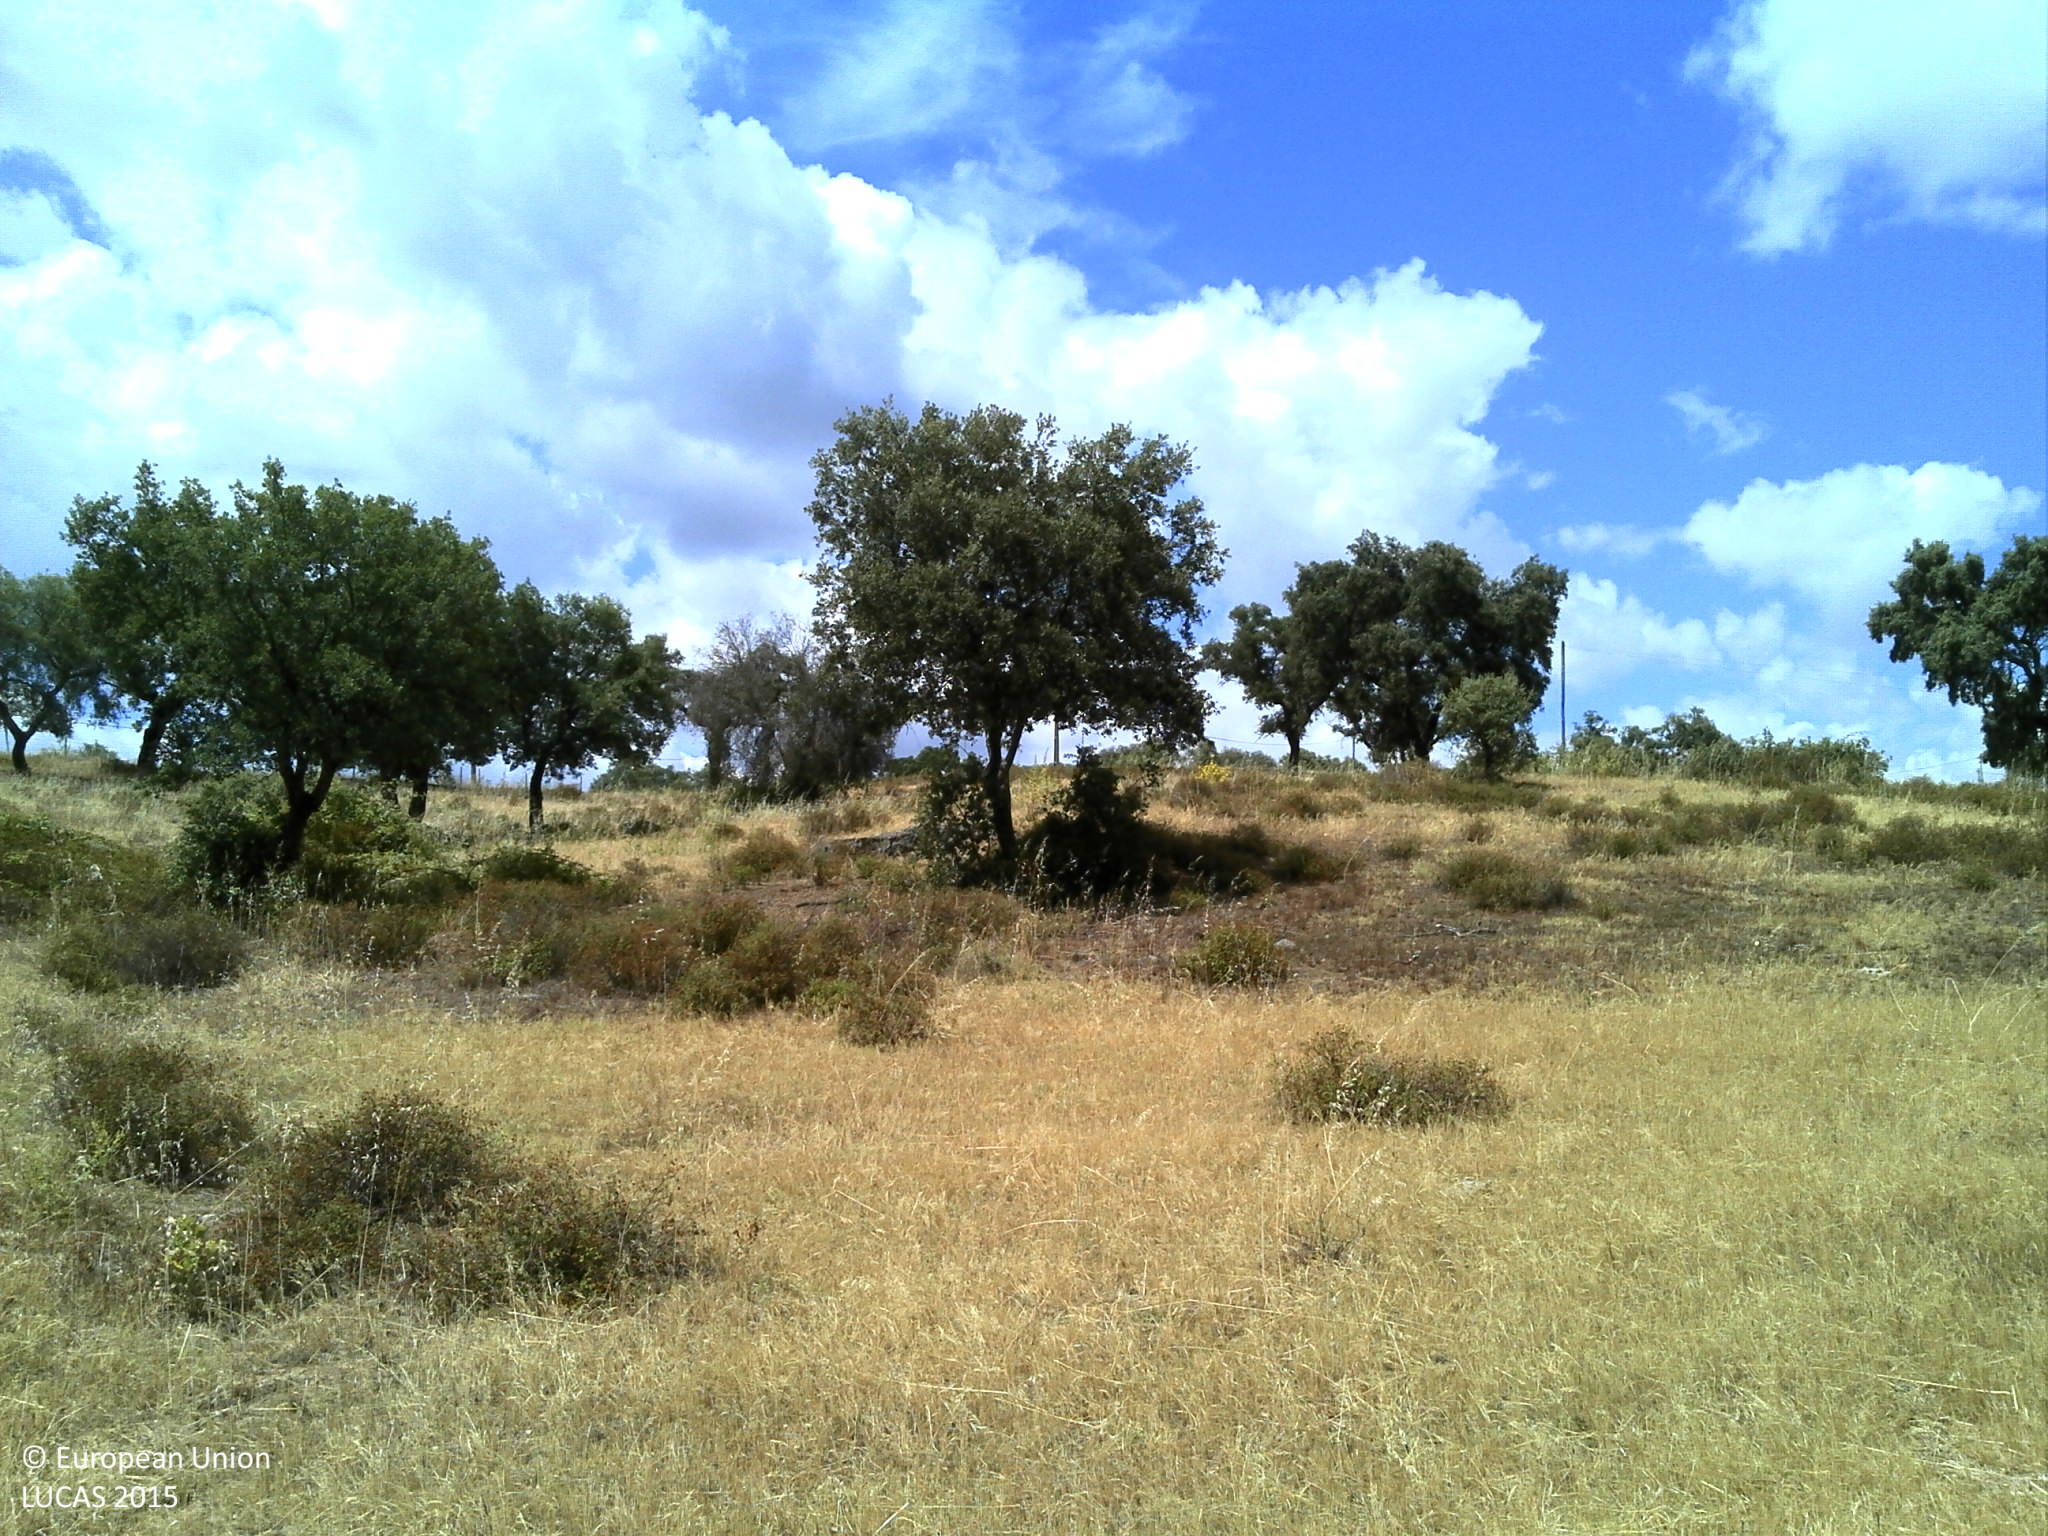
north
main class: Woodland
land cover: Broadleaved woodland
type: broadleaved evergreen forest
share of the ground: 10 - 25 %
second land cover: Shrubland without tree cover
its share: 50 - 75 %
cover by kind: shrubs 50 %, broadleaved forest trees 25 %, unconsolidated bare surface 20 %, herbaceous plants 5 %
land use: Forestry
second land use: Agriculture (excluding fallow land and kitchen gardens)
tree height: > 5 m
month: June
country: PT
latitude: 38.5507
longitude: -8.0930
